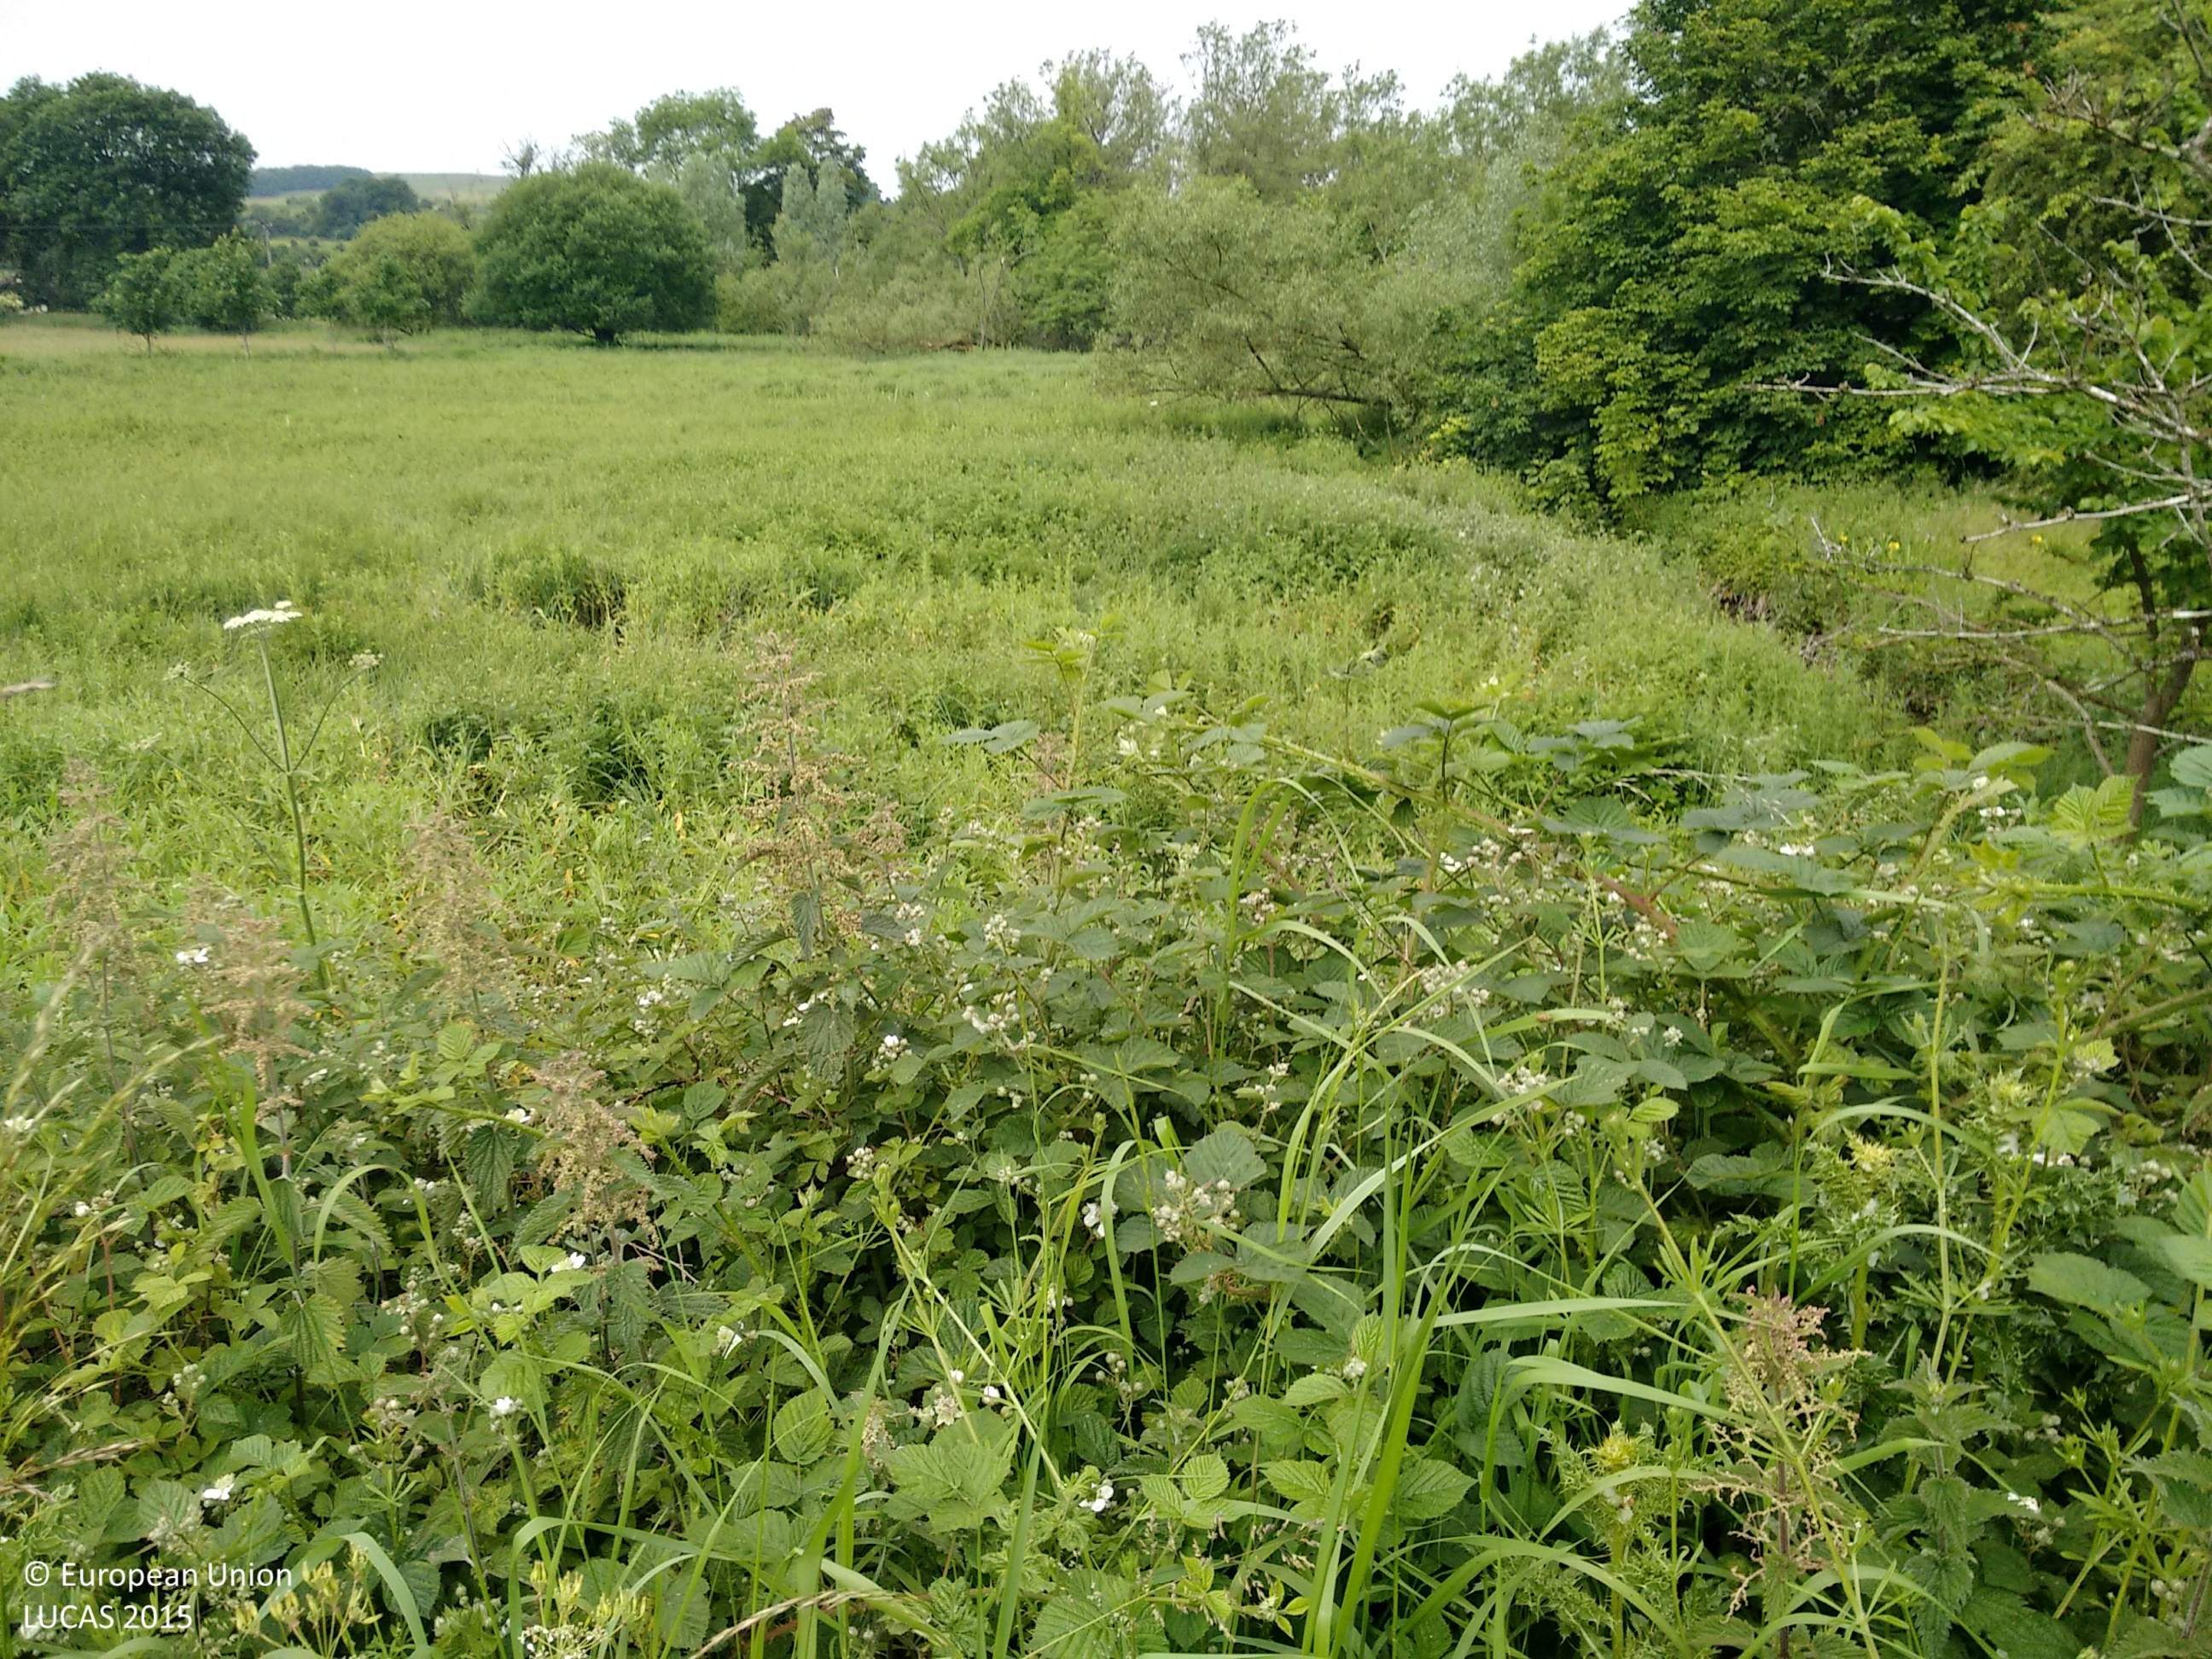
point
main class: Grassland
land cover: Grassland without tree/shrub cover
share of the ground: > 75 %
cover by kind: herbaceous plants 100 %
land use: Agriculture (excluding fallow land and kitchen gardens)
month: June
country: GB
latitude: 53.2741
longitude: -1.6441
